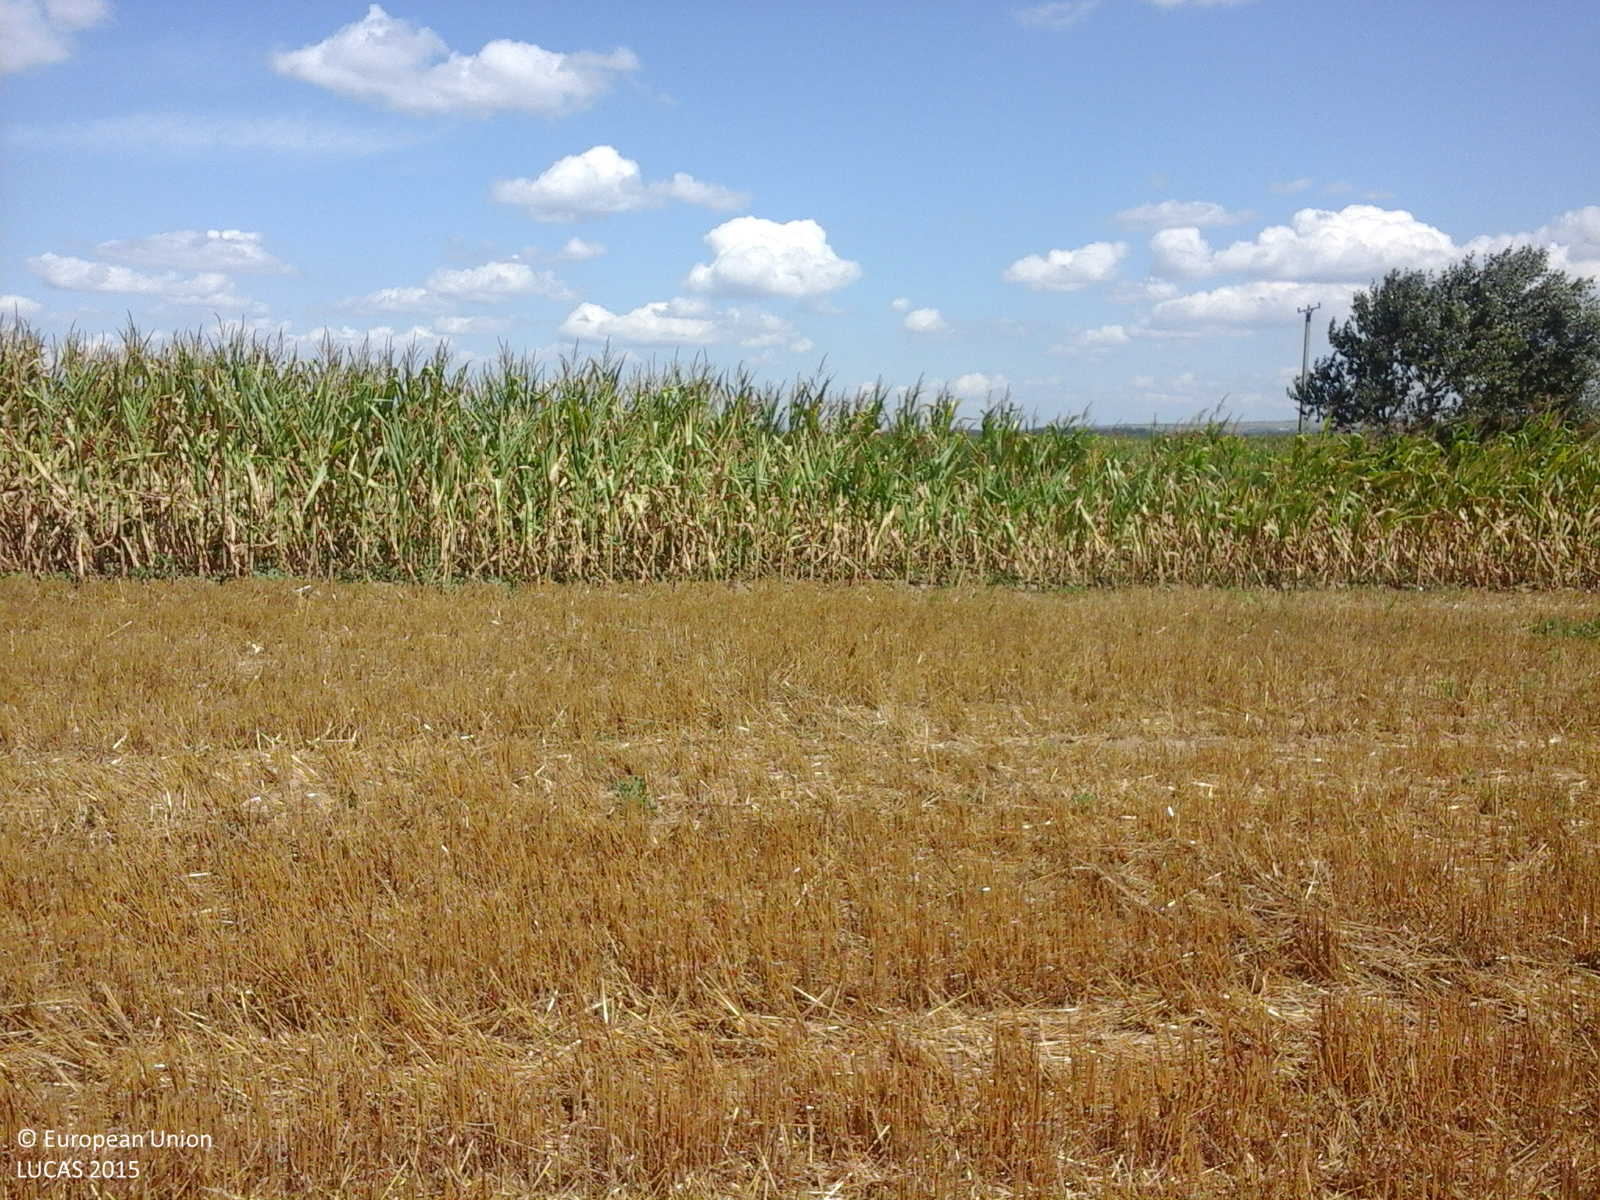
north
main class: Cropland
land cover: Common wheat
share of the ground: 50 - 75 %
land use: Agriculture (excluding fallow land and kitchen gardens)
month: July
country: RO
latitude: 46.4268
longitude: 28.2343
